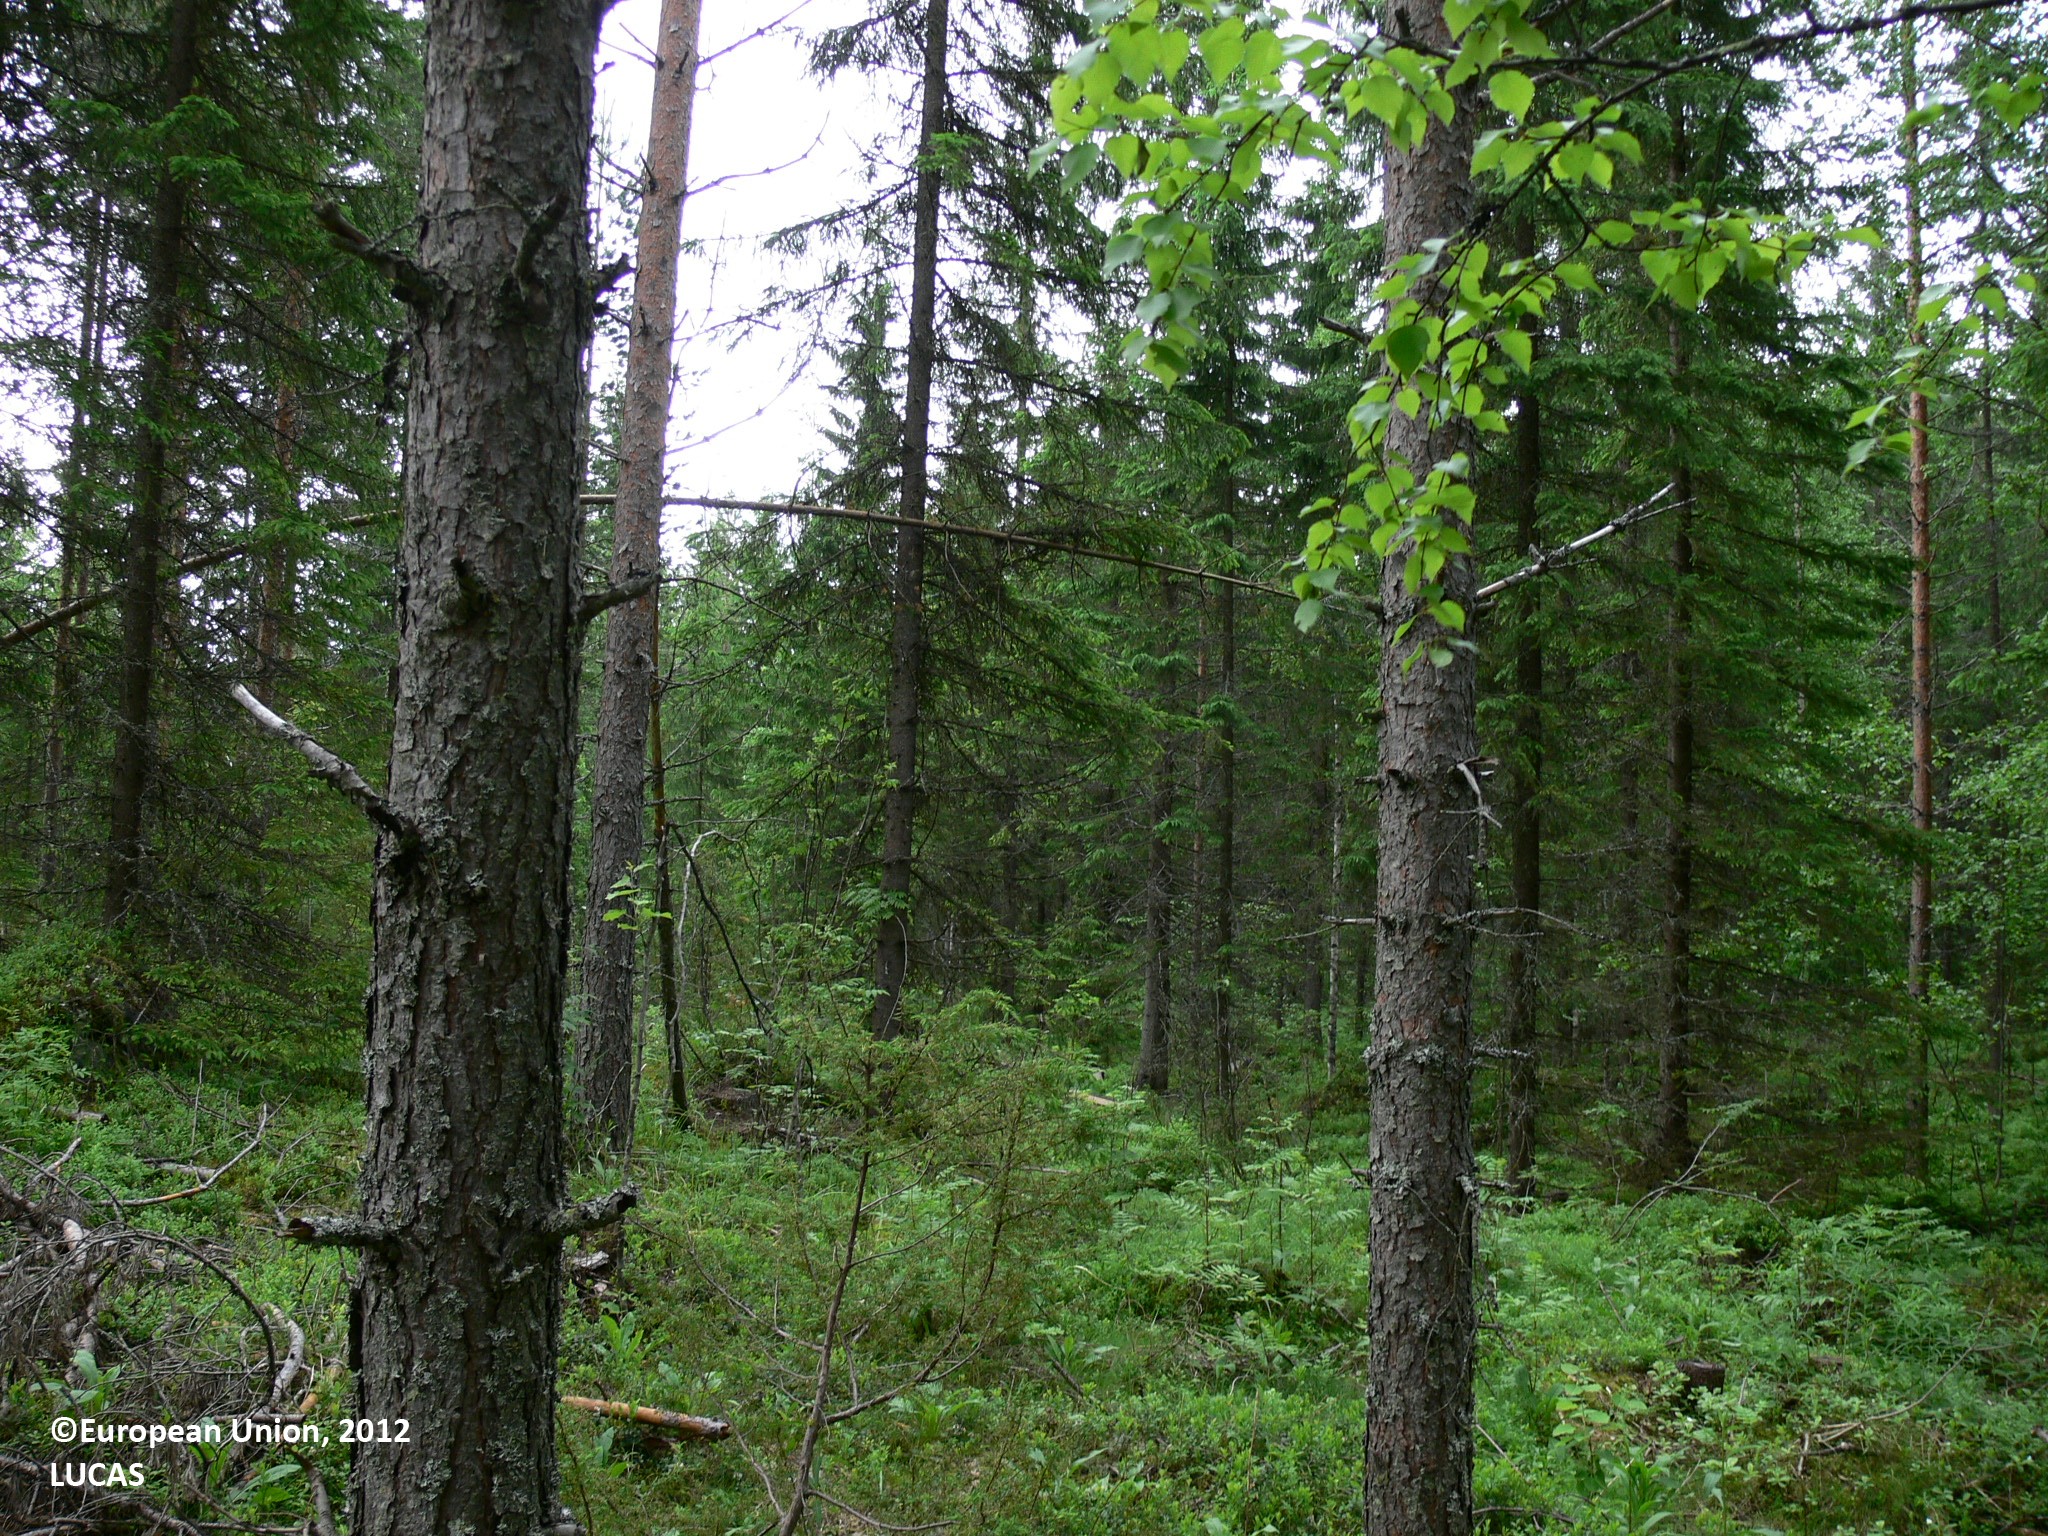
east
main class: Woodland
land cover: Pine dominated coniferous woodland
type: boreal forest
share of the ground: 50 - 75 %
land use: Forestry
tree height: > 5 m
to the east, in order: Pine dominated coniferous woodland; Other coniferous woodland; Spruce dominated coniferous woodland; Ditches and canals; Spruce dominated coniferous woodland; Other mixed woodland; Pine dominated coniferous woodland; Other mixed woodland
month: June
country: FI
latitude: 62.7101
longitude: 30.3922
